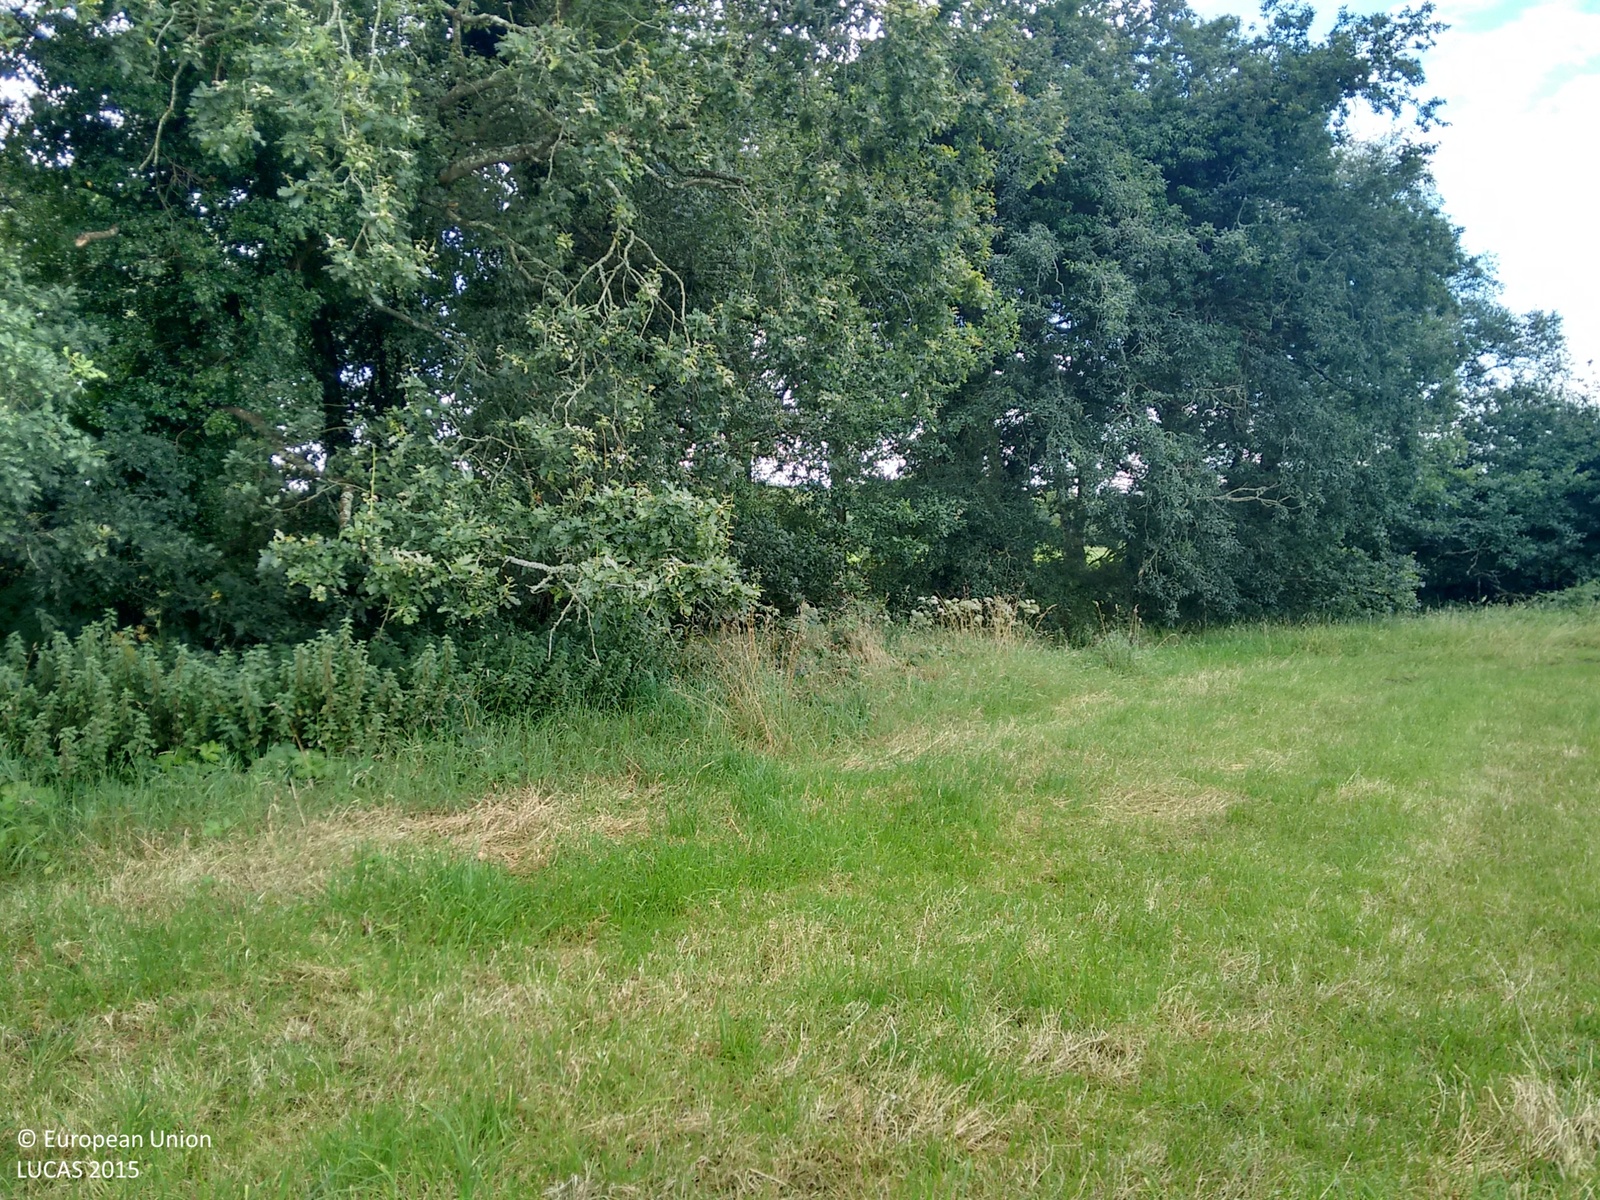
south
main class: Grassland
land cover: Grassland without tree/shrub cover
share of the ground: > 75 %
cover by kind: herbaceous plants 95 %, unconsolidated bare surface 5 %
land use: Agriculture (excluding fallow land and kitchen gardens)
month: August
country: IE
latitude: 52.6028
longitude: -8.2732
